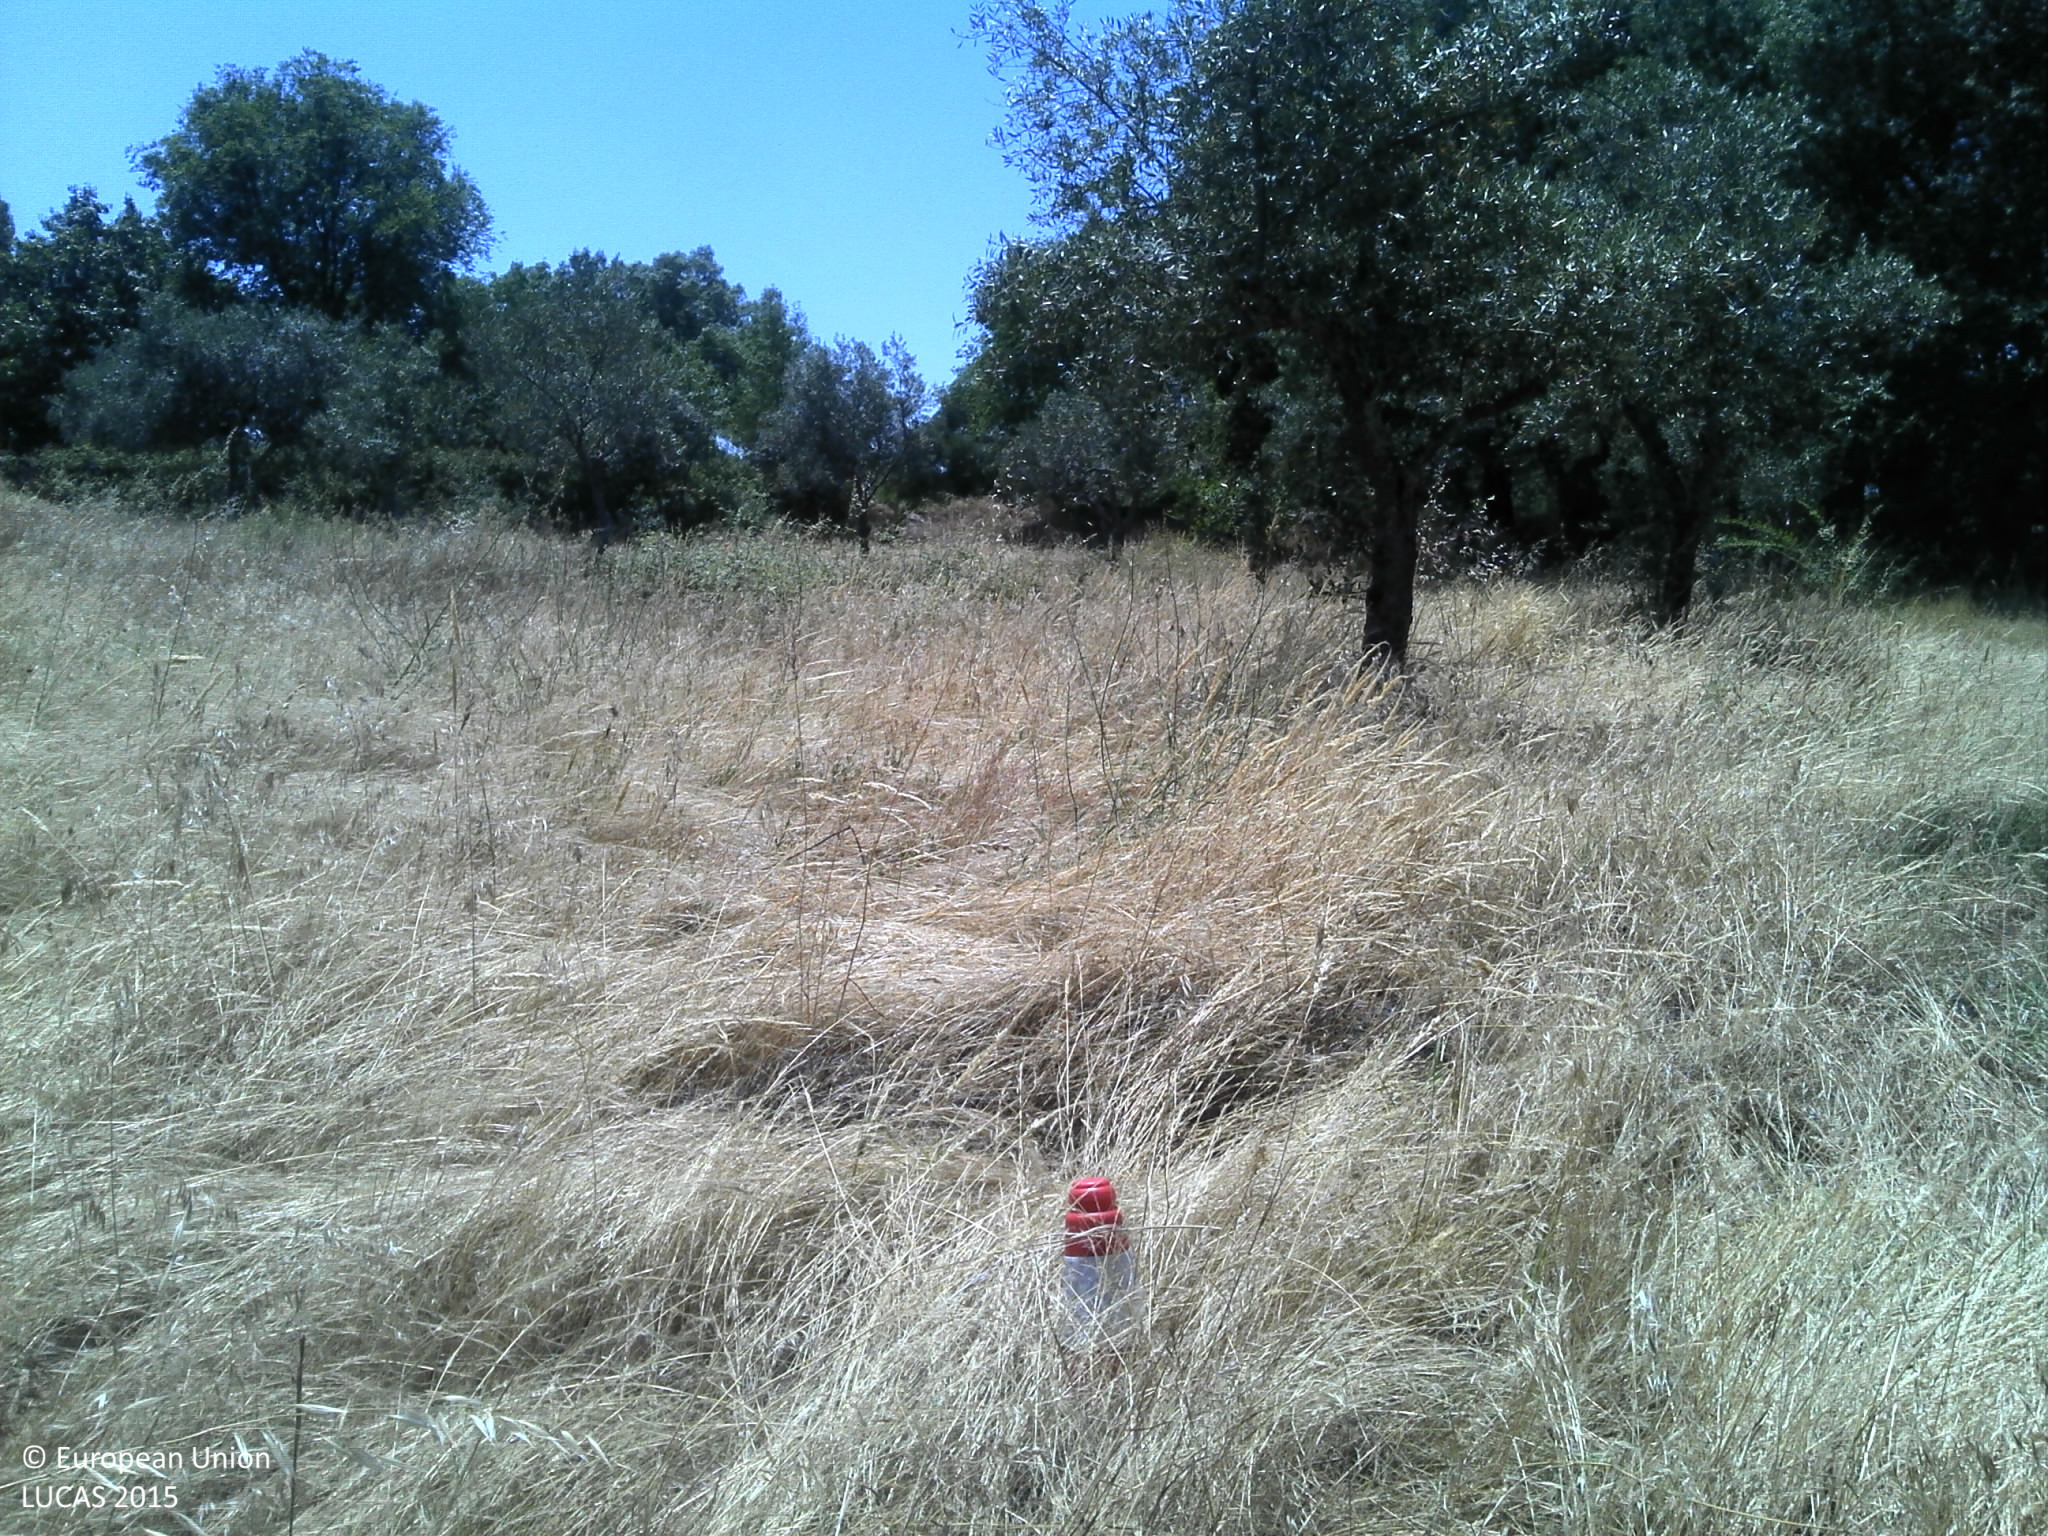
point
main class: Cropland
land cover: Olive groves
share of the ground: 25 - 50 %
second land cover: Grassland without tree/shrub cover
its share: 50 - 75 %
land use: Agriculture (excluding fallow land and kitchen gardens)
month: June
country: PT
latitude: 39.9168
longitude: -7.4014
